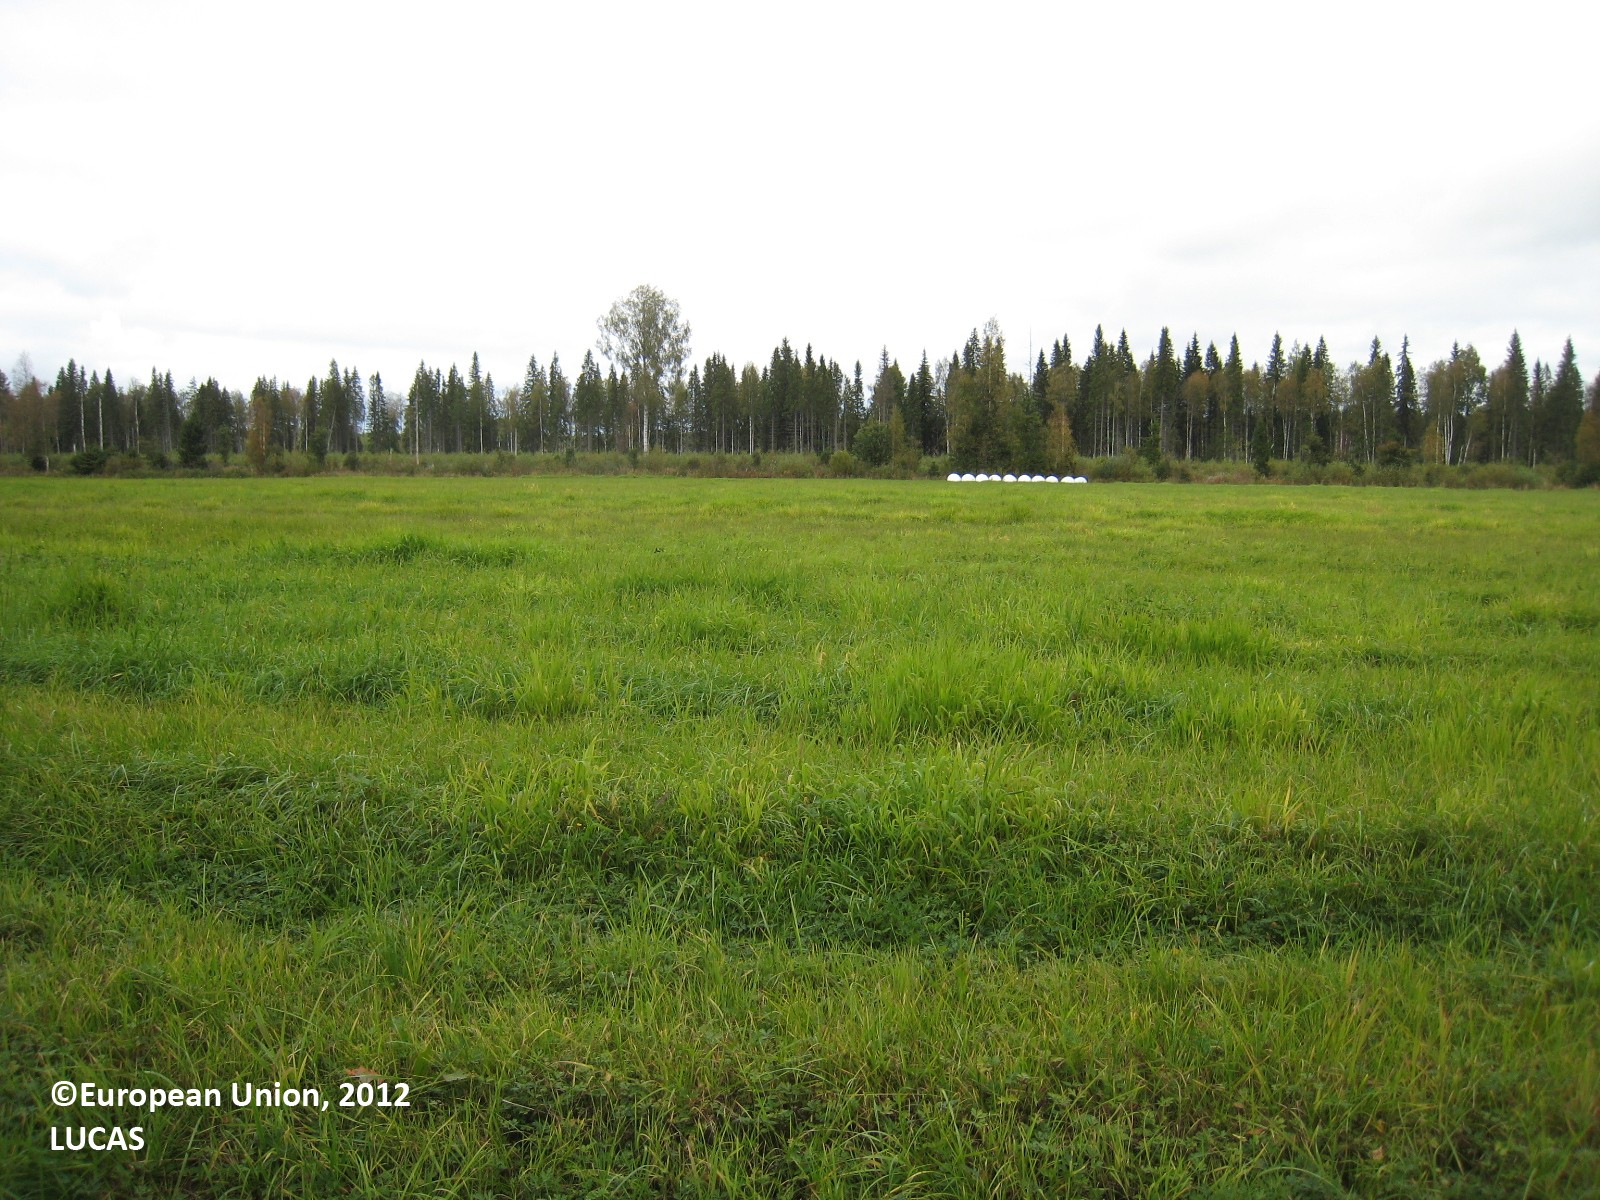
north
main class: Cropland
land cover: Temporary grasslands
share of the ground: > 75 %
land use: Agriculture (excluding fallow land and kitchen gardens)
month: September
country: FI
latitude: 63.2320
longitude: 26.4681
